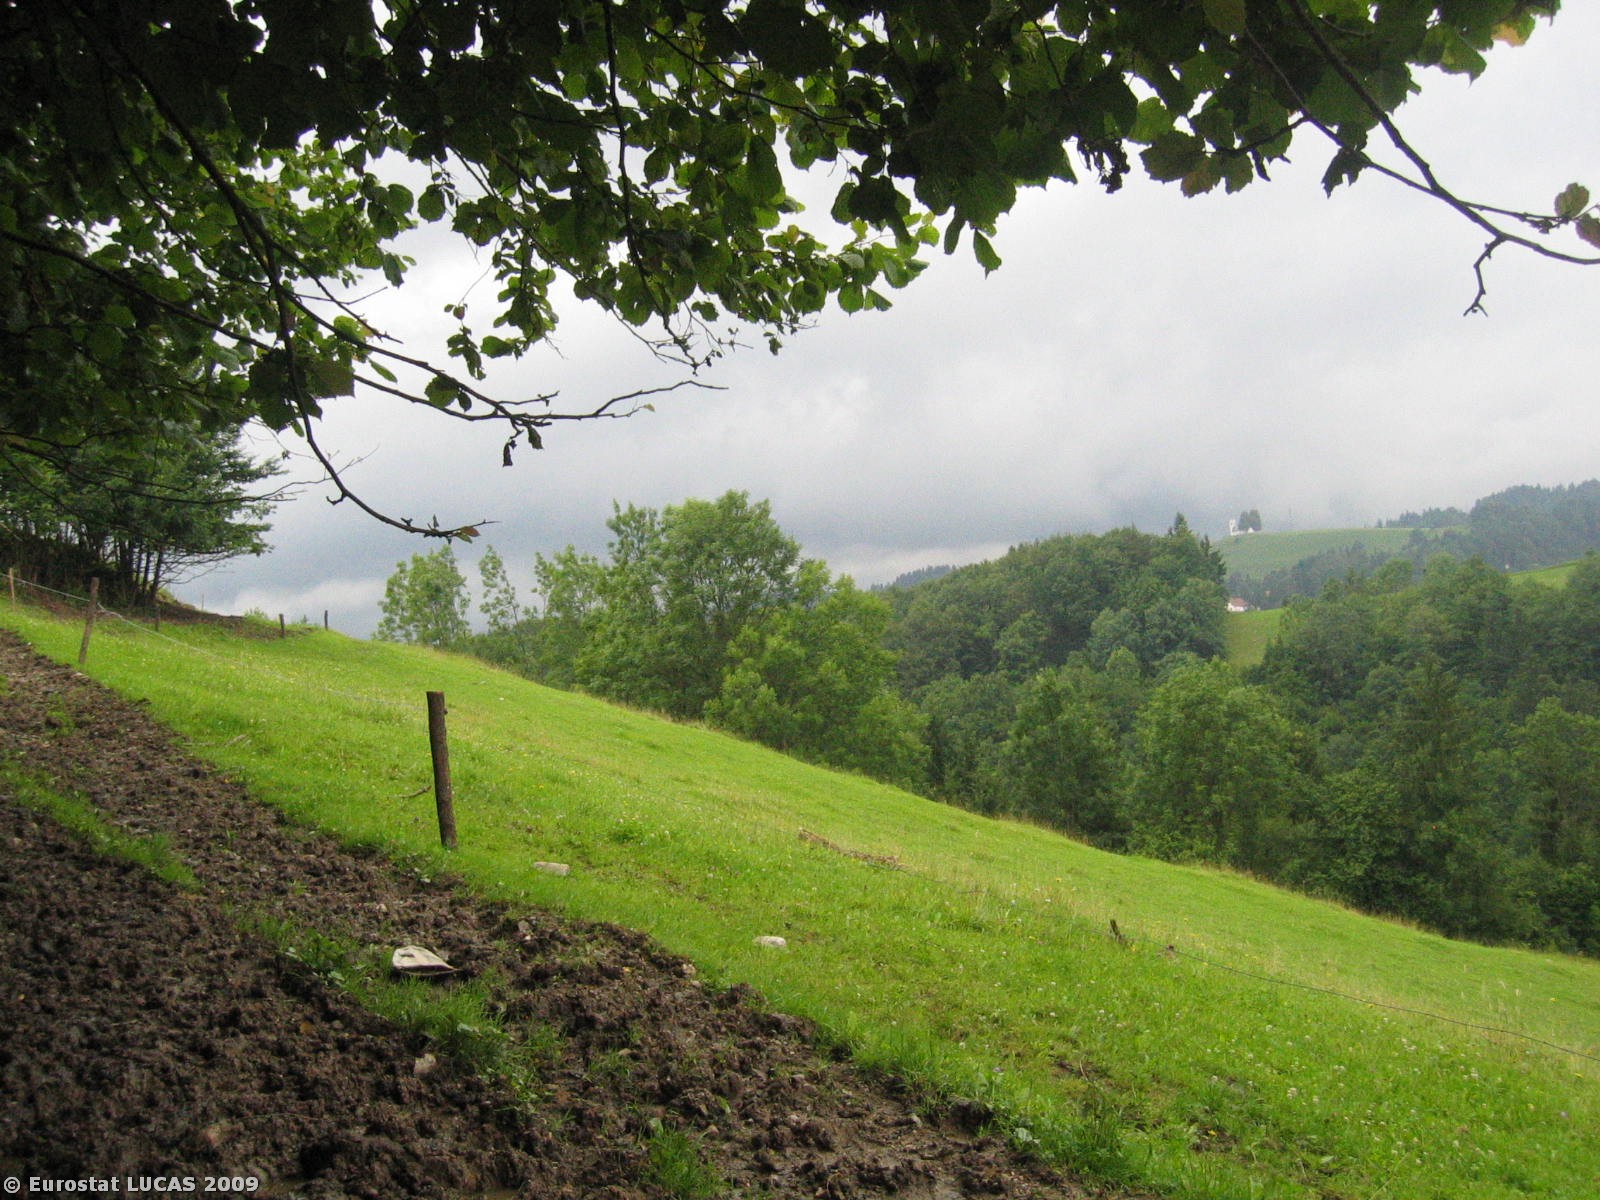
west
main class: Grassland
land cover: Grassland without tree/shrub cover
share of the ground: > 75 %
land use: Agriculture (excluding fallow land and kitchen gardens)
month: July
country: SI
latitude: 45.9615
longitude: 14.2156
